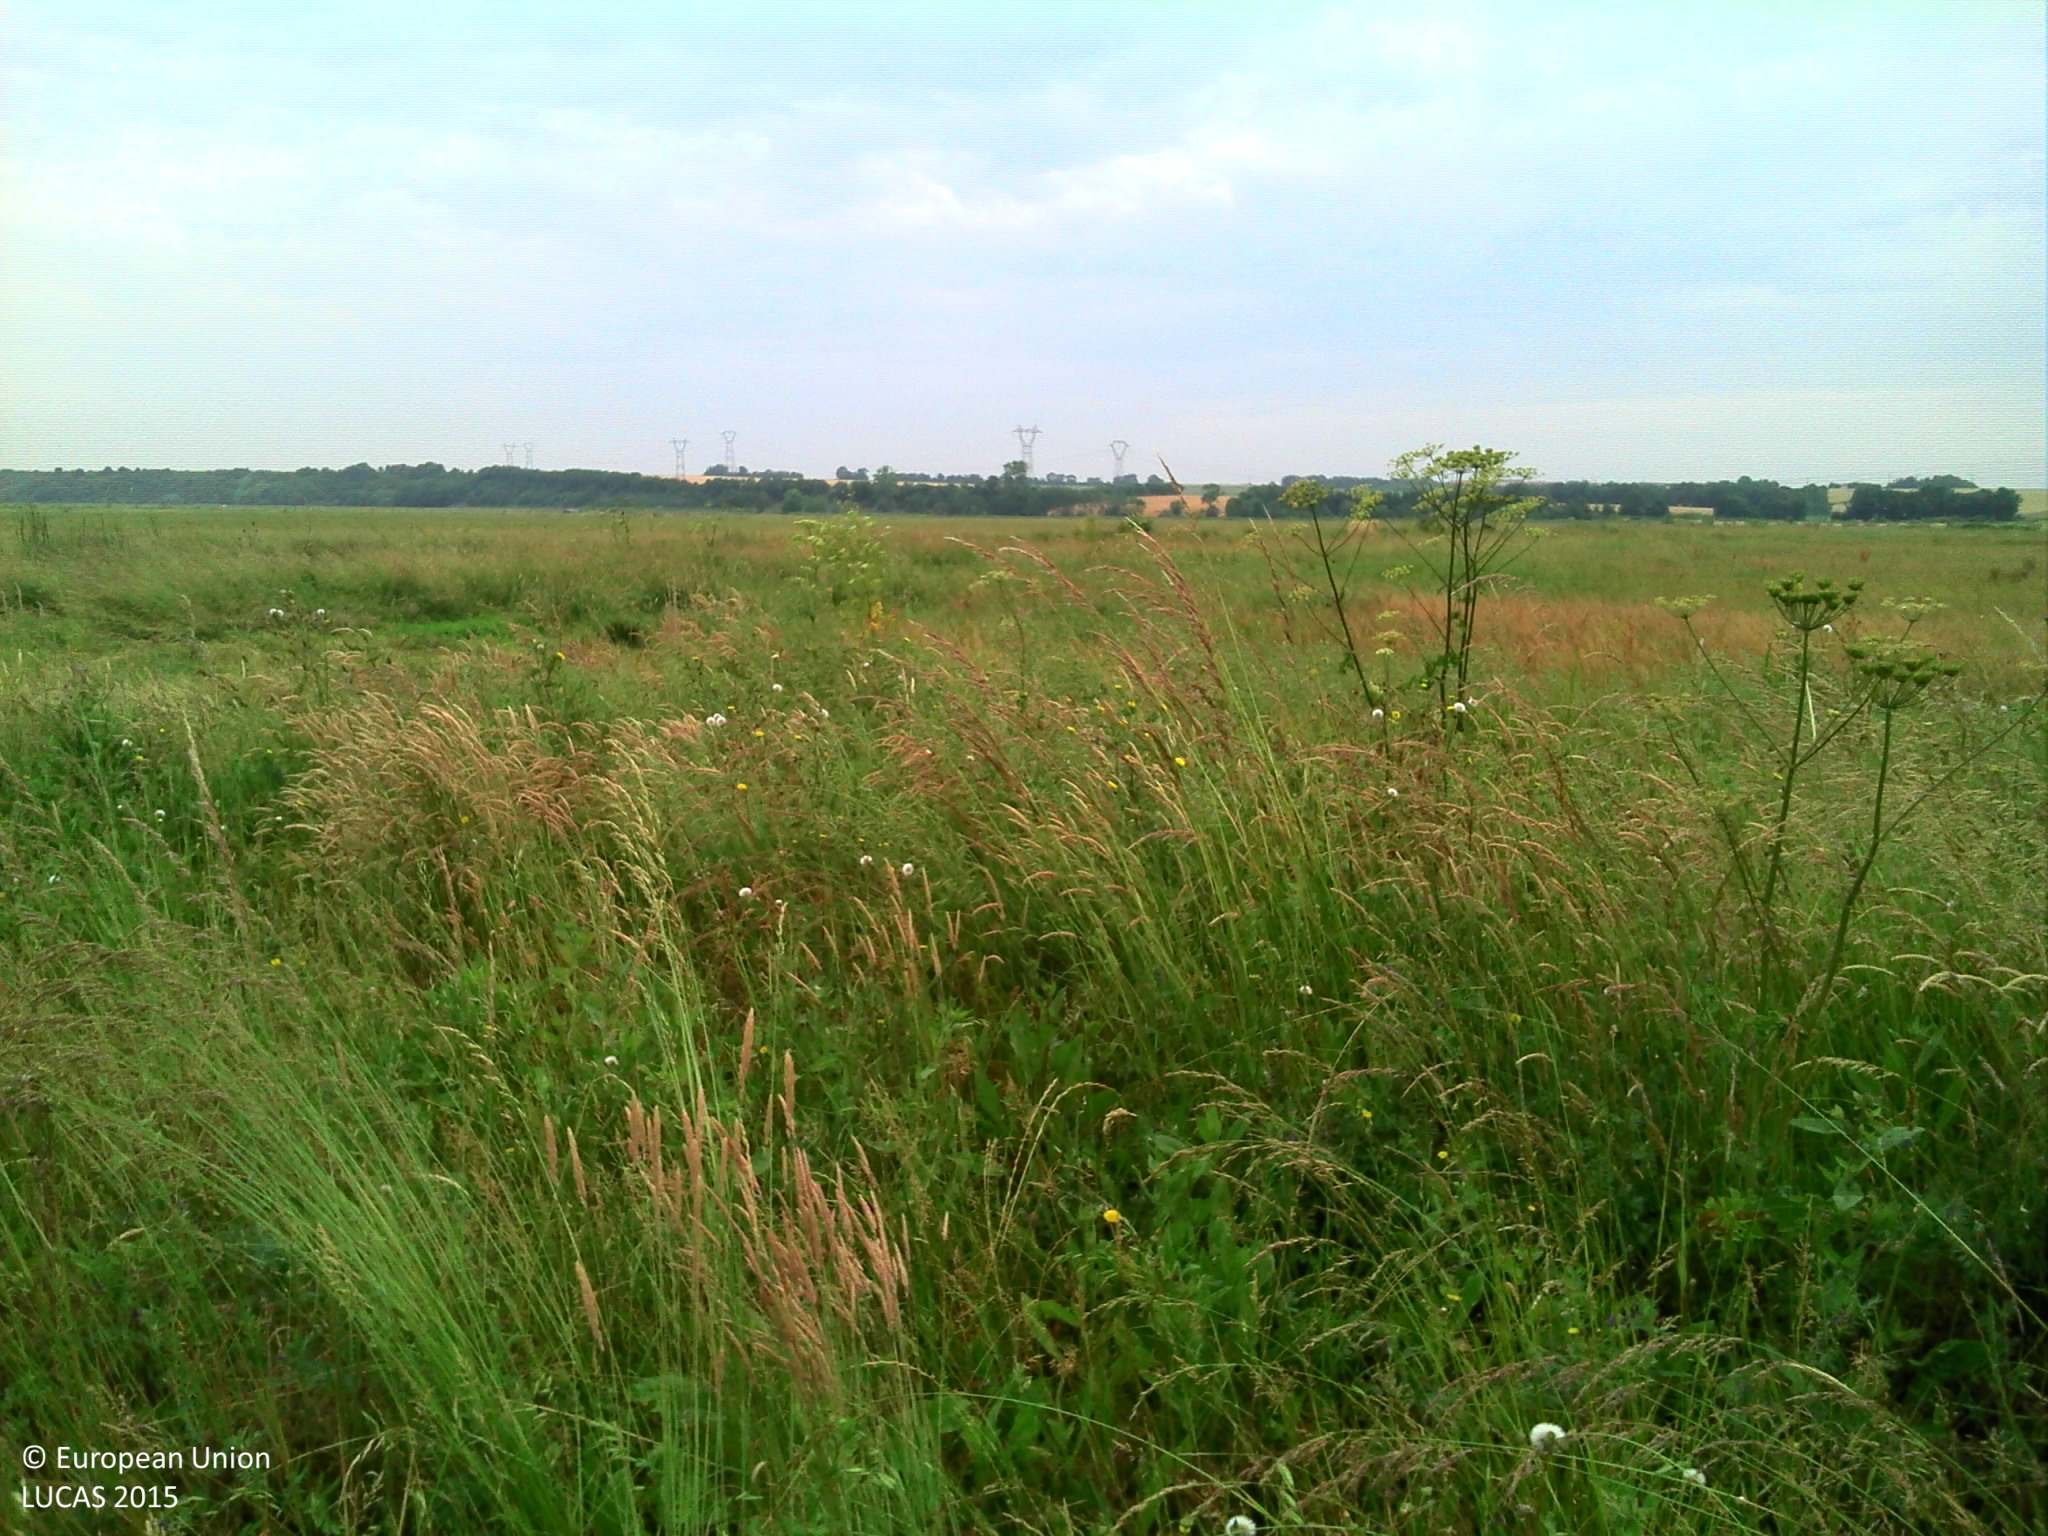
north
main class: Grassland
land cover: Grassland without tree/shrub cover
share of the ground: > 75 %
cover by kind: herbaceous plants 95 %, shrubs 5 %
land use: Agriculture (excluding fallow land and kitchen gardens)
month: June
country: FR
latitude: 46.0089
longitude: -0.9154
